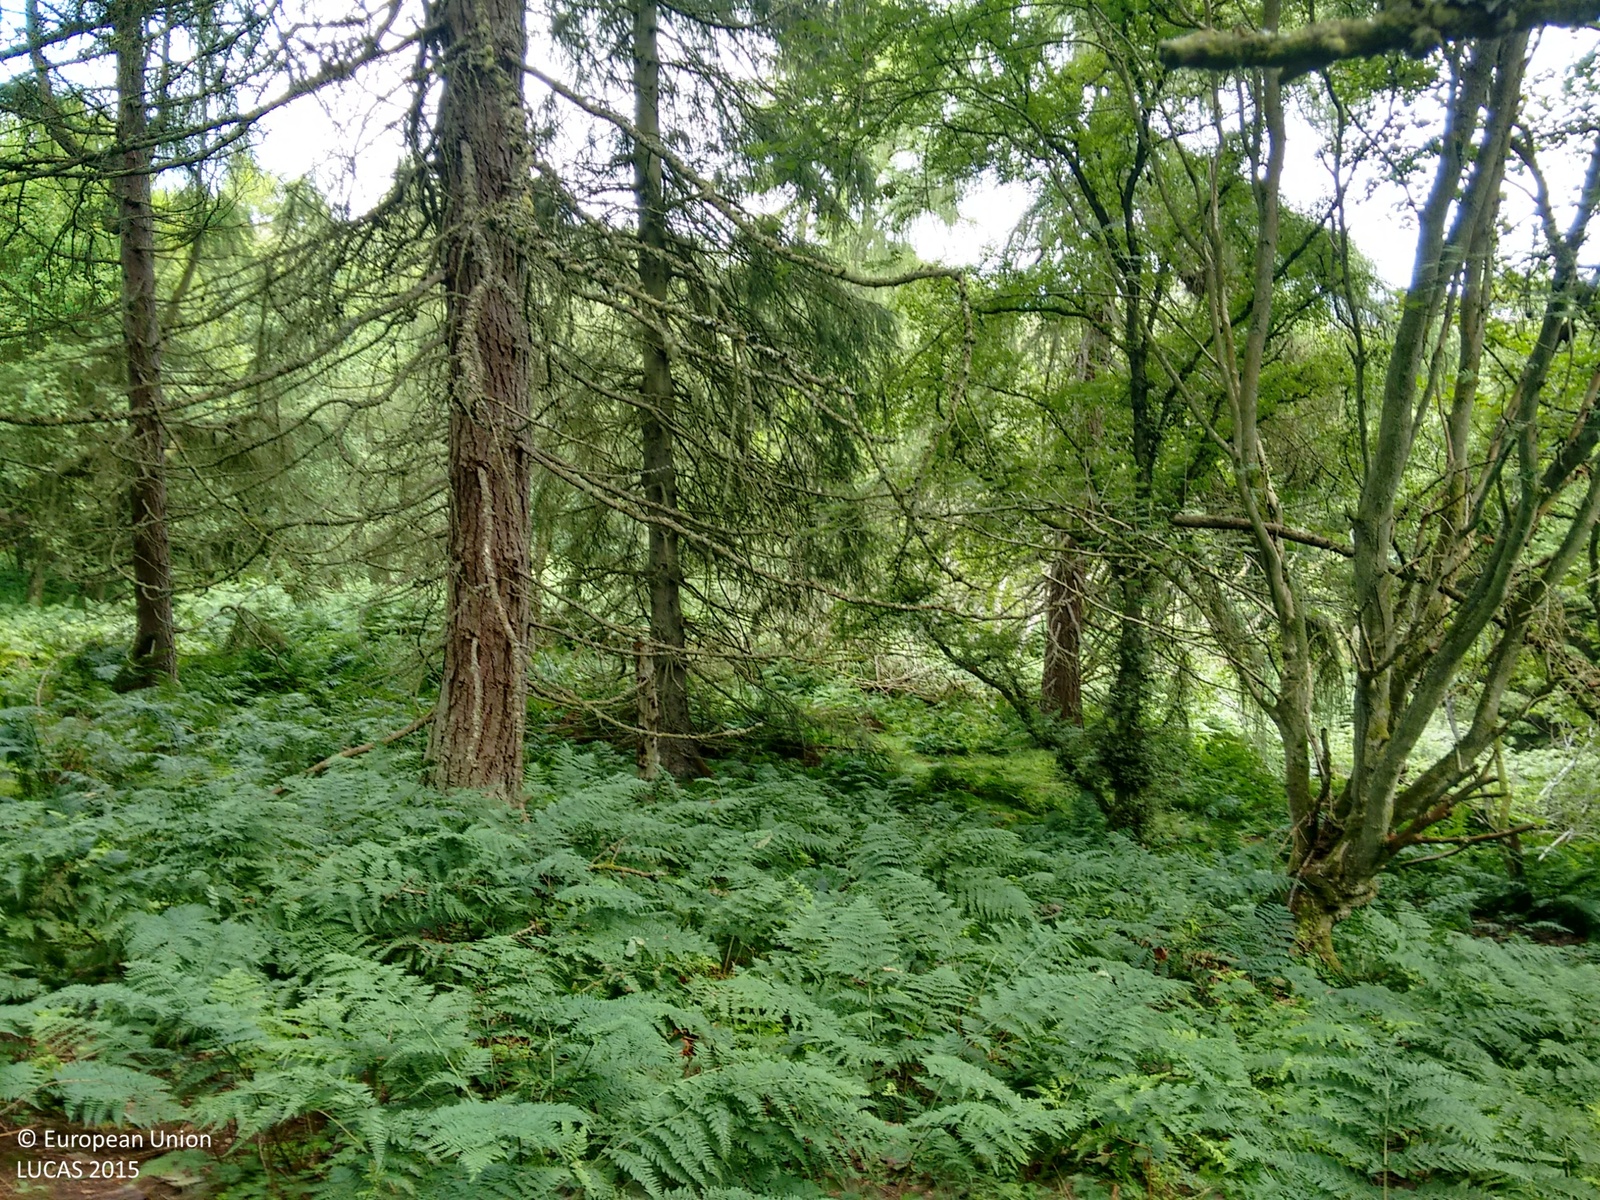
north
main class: Woodland
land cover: Other mixed woodland
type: acidophilous oak and oak-birch forest
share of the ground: > 75 %
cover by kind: coniferous forest trees 60 %, broadleaved forest trees 35 %, herbaceous plants 5 %
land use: Forestry
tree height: > 5 m
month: July
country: GB
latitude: 56.3860
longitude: -2.9416
